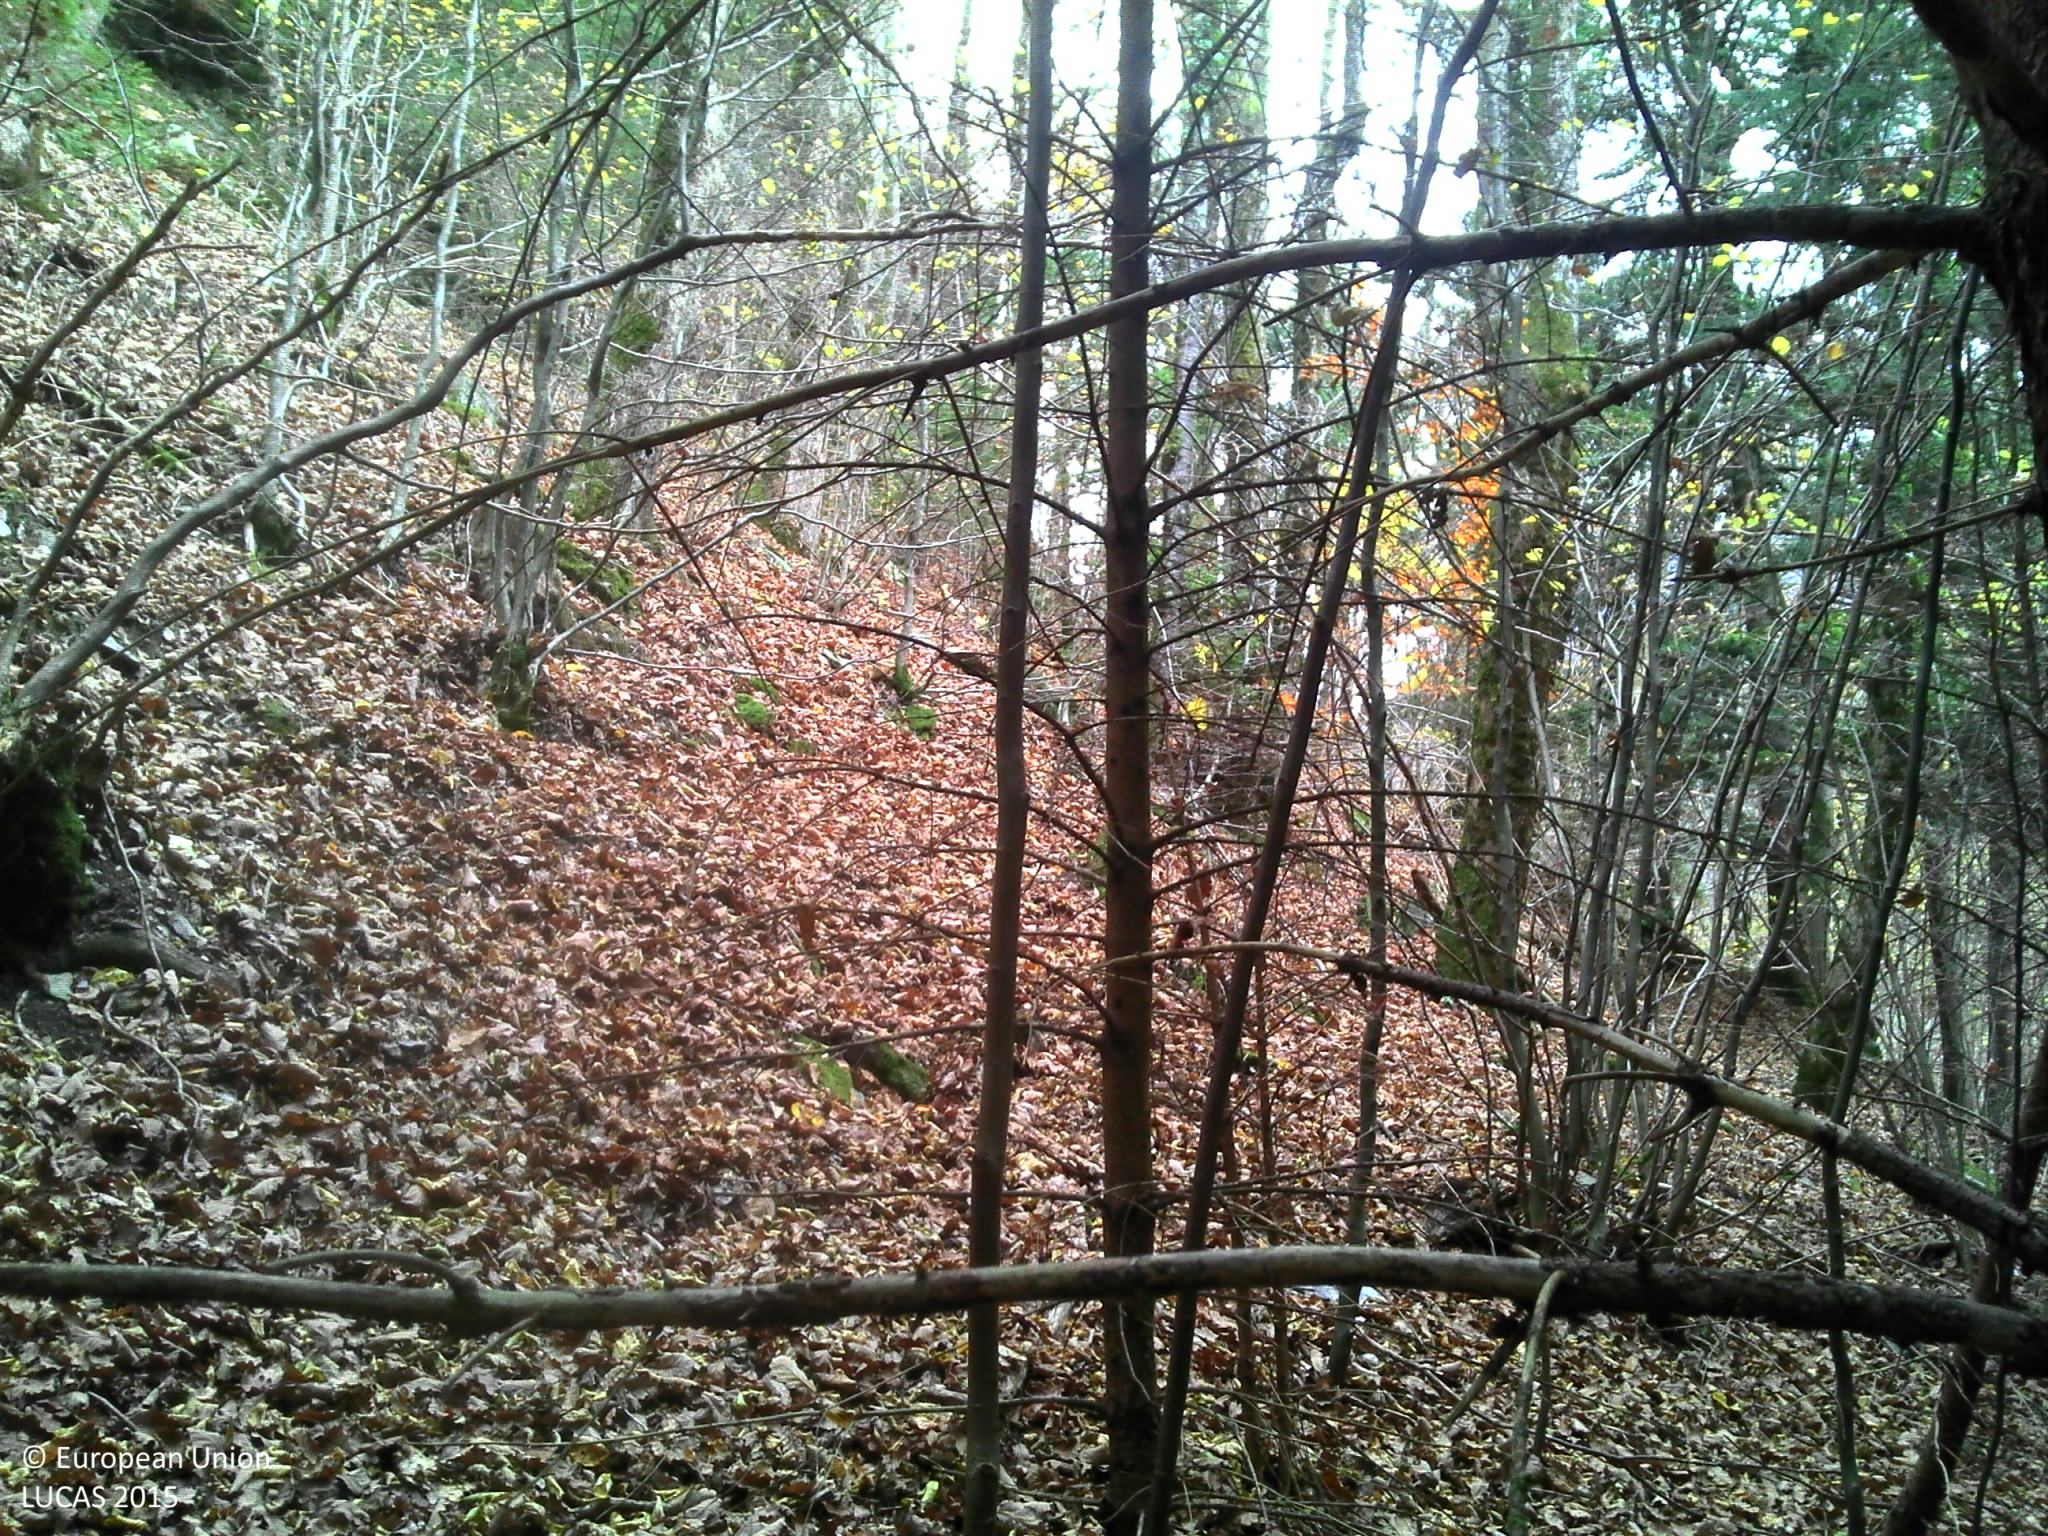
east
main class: Woodland
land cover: Spruce dominated mixed woodland
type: hemiboreal forest and nemoral coniferous forest and mixed broadleaved-coniferous forest
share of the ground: > 75 %
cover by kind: coniferous forest trees 50 %, broadleaved forest trees 40 %, consolidated bare surface 10 %
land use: Forestry
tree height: > 5 m
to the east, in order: Spruce dominated mixed woodland
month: November
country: FR
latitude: 45.7160
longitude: 6.4713
